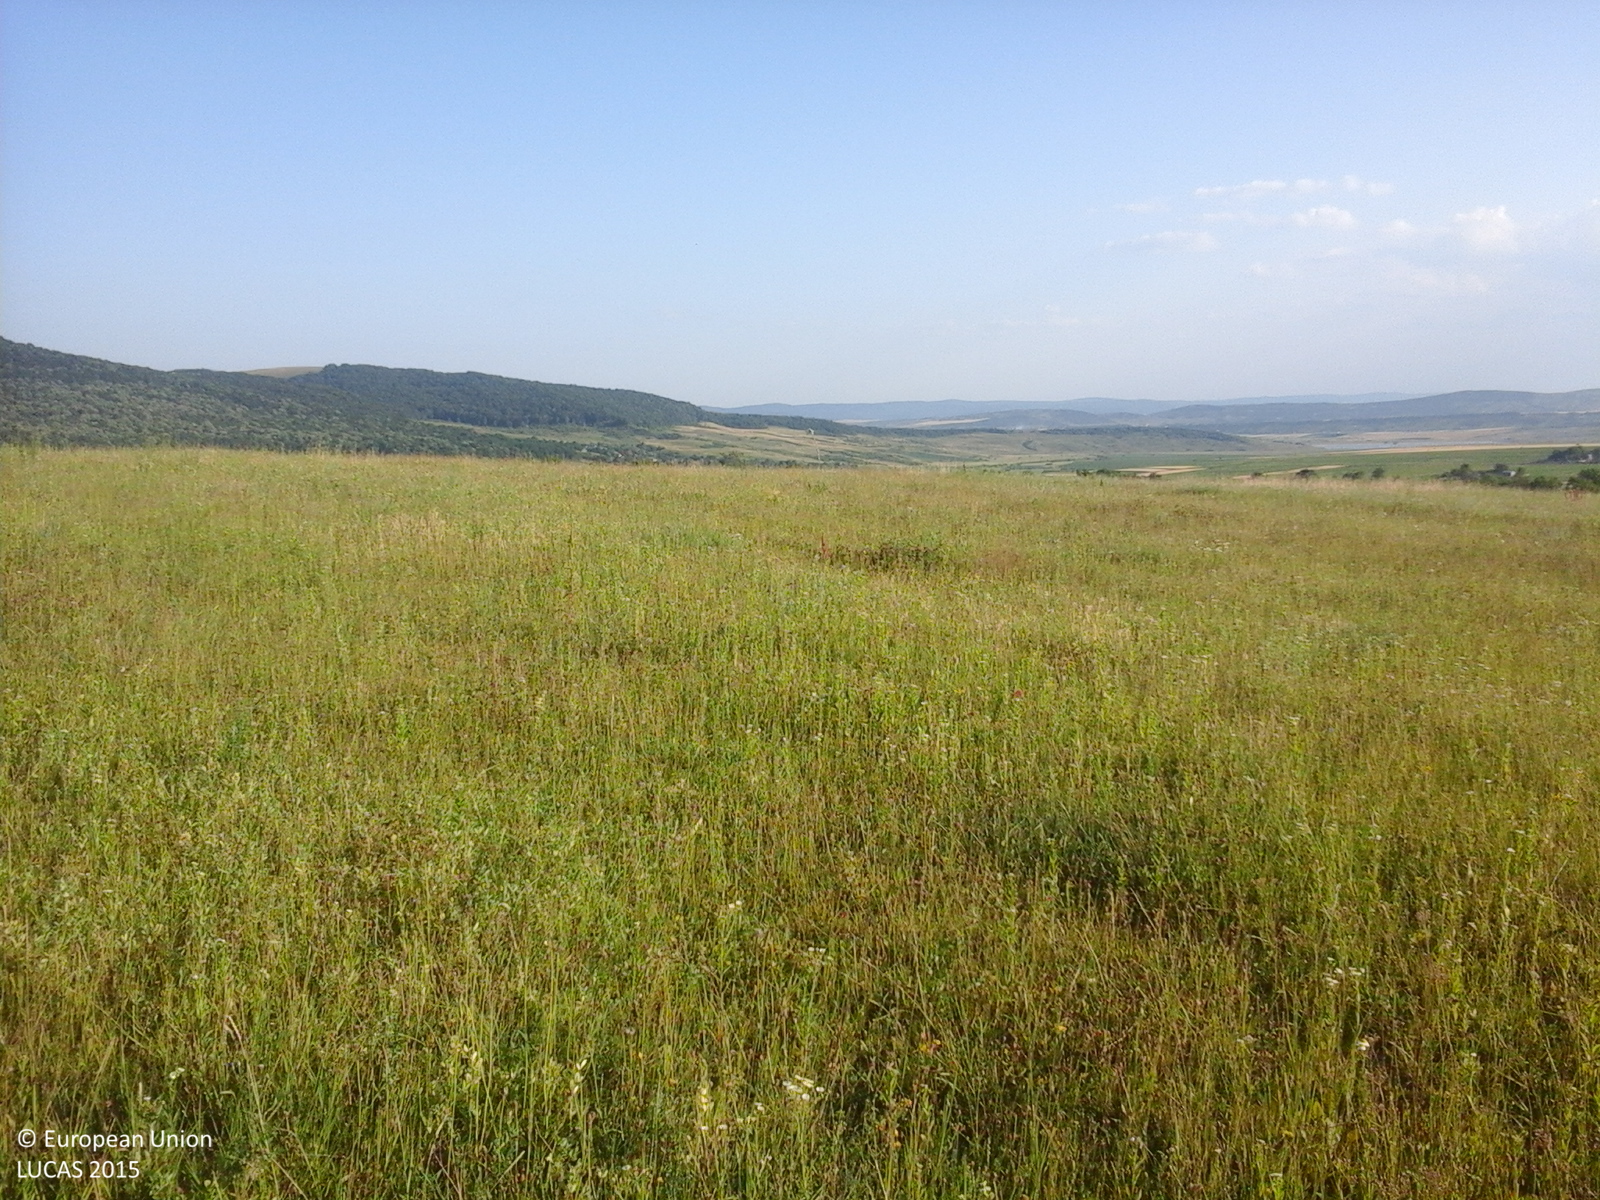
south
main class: Grassland
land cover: Grassland without tree/shrub cover
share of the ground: > 75 %
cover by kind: herbaceous plants 100 %
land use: Agriculture (excluding fallow land and kitchen gardens)
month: June
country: RO
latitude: 46.9774
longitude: 27.3706
